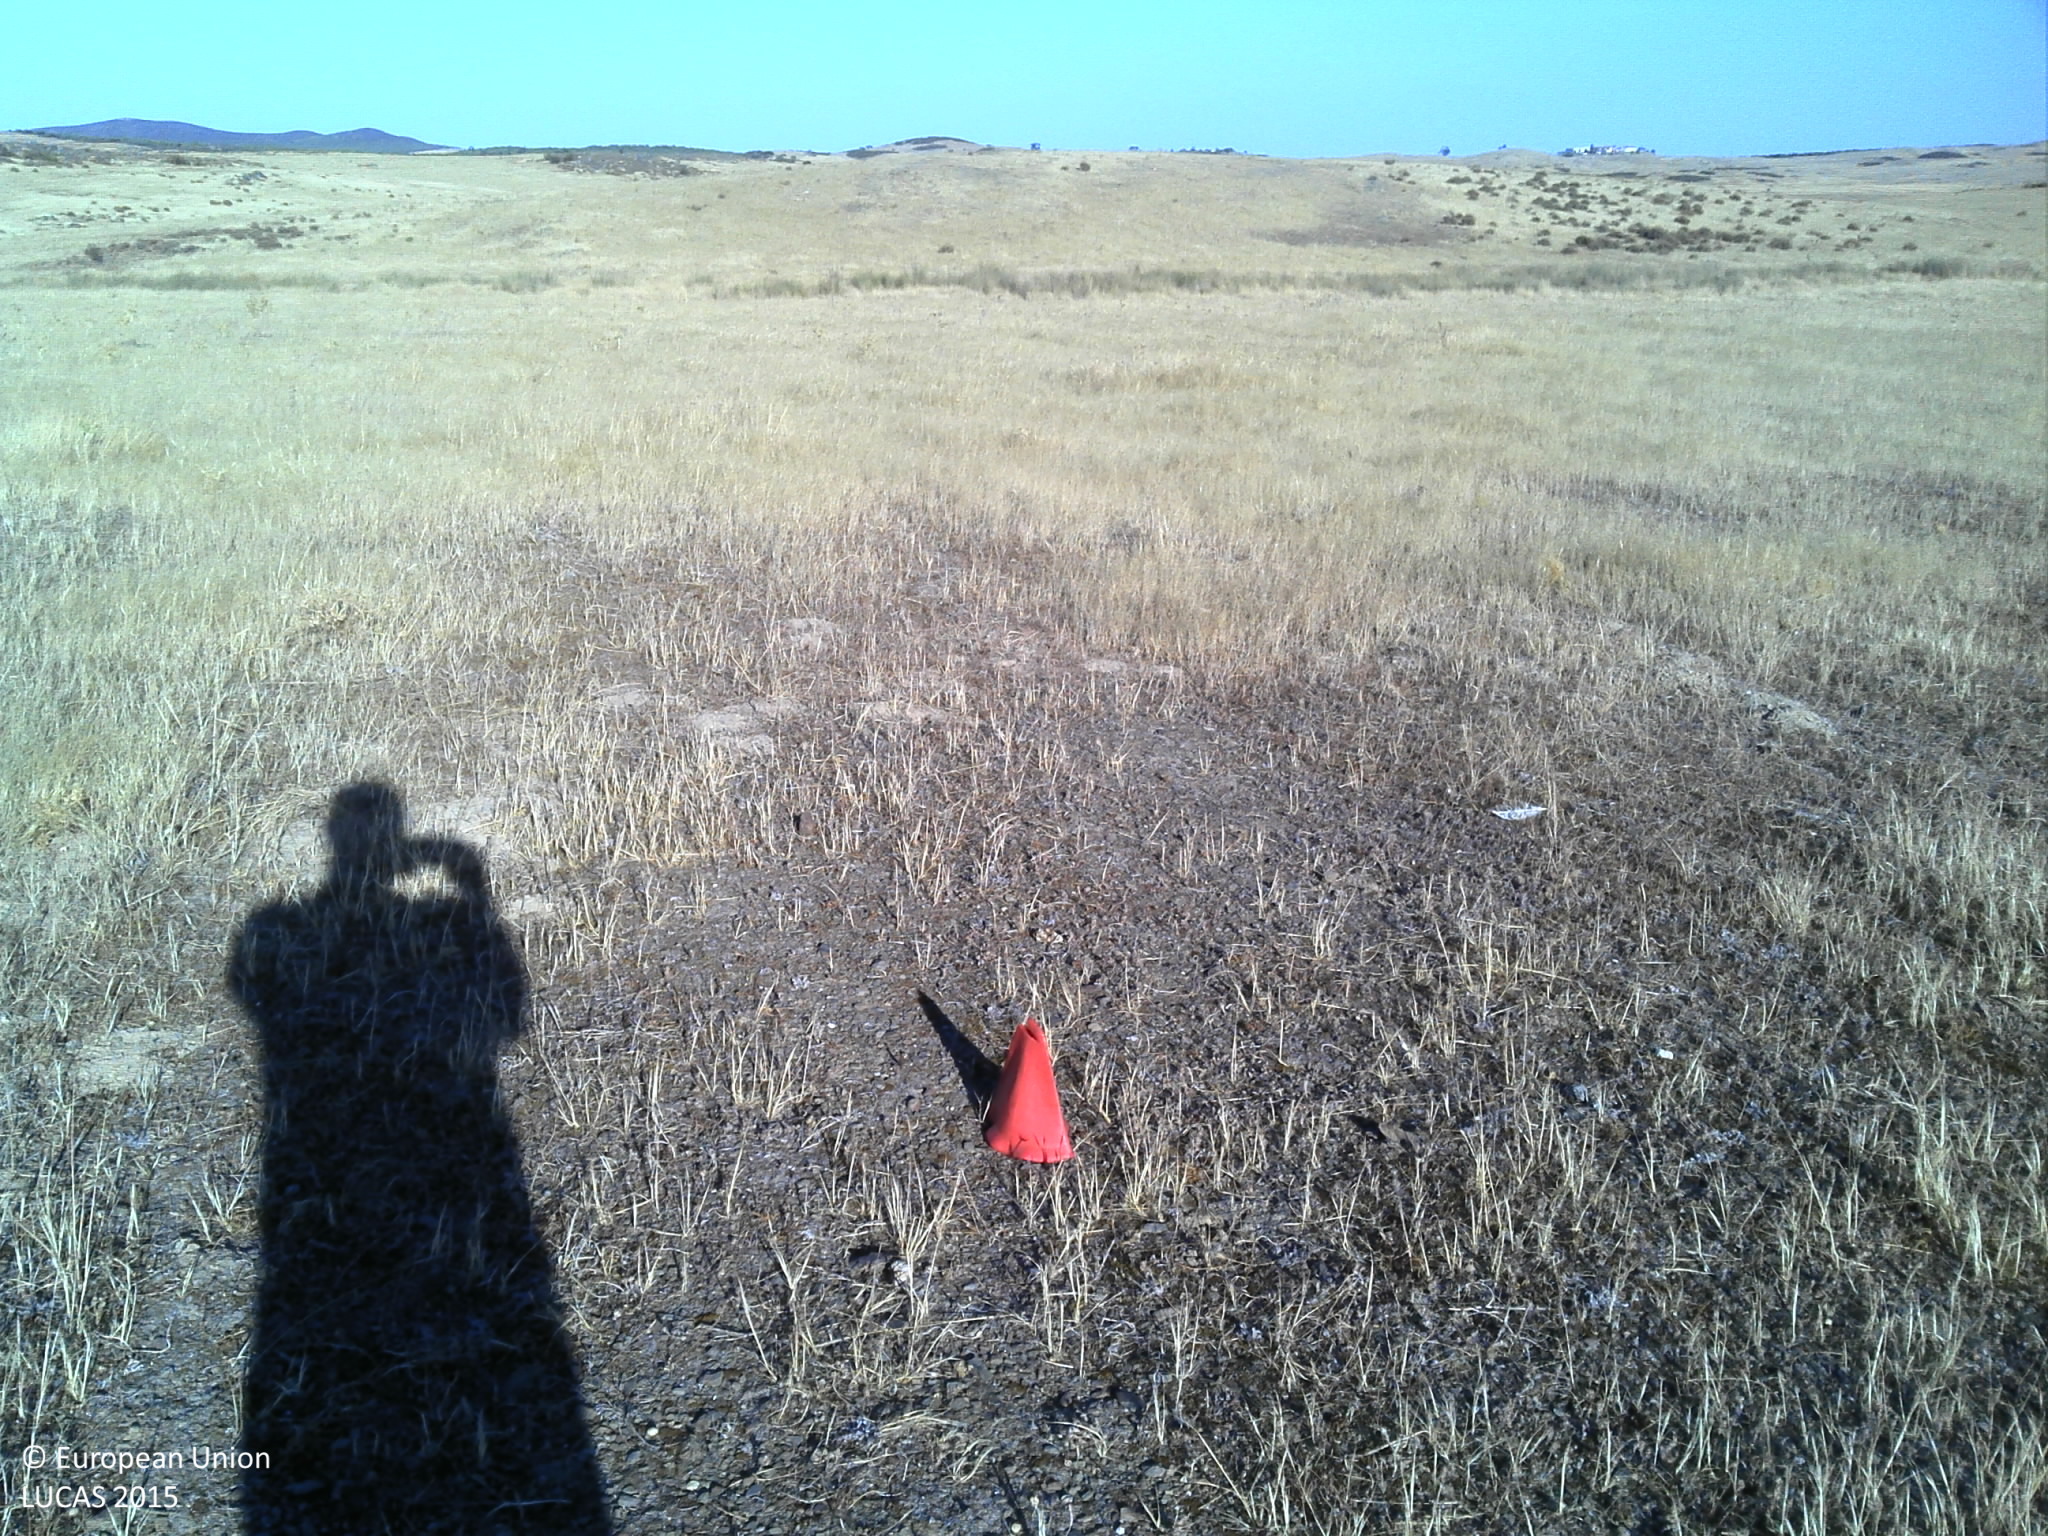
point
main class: Grassland
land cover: Grassland without tree/shrub cover
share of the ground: < 10 %
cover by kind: unconsolidated bare surface 90 %, herbaceous plants 10 %
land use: Agriculture (excluding fallow land and kitchen gardens)
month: July
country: PT
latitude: 37.6632
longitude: -7.8987
